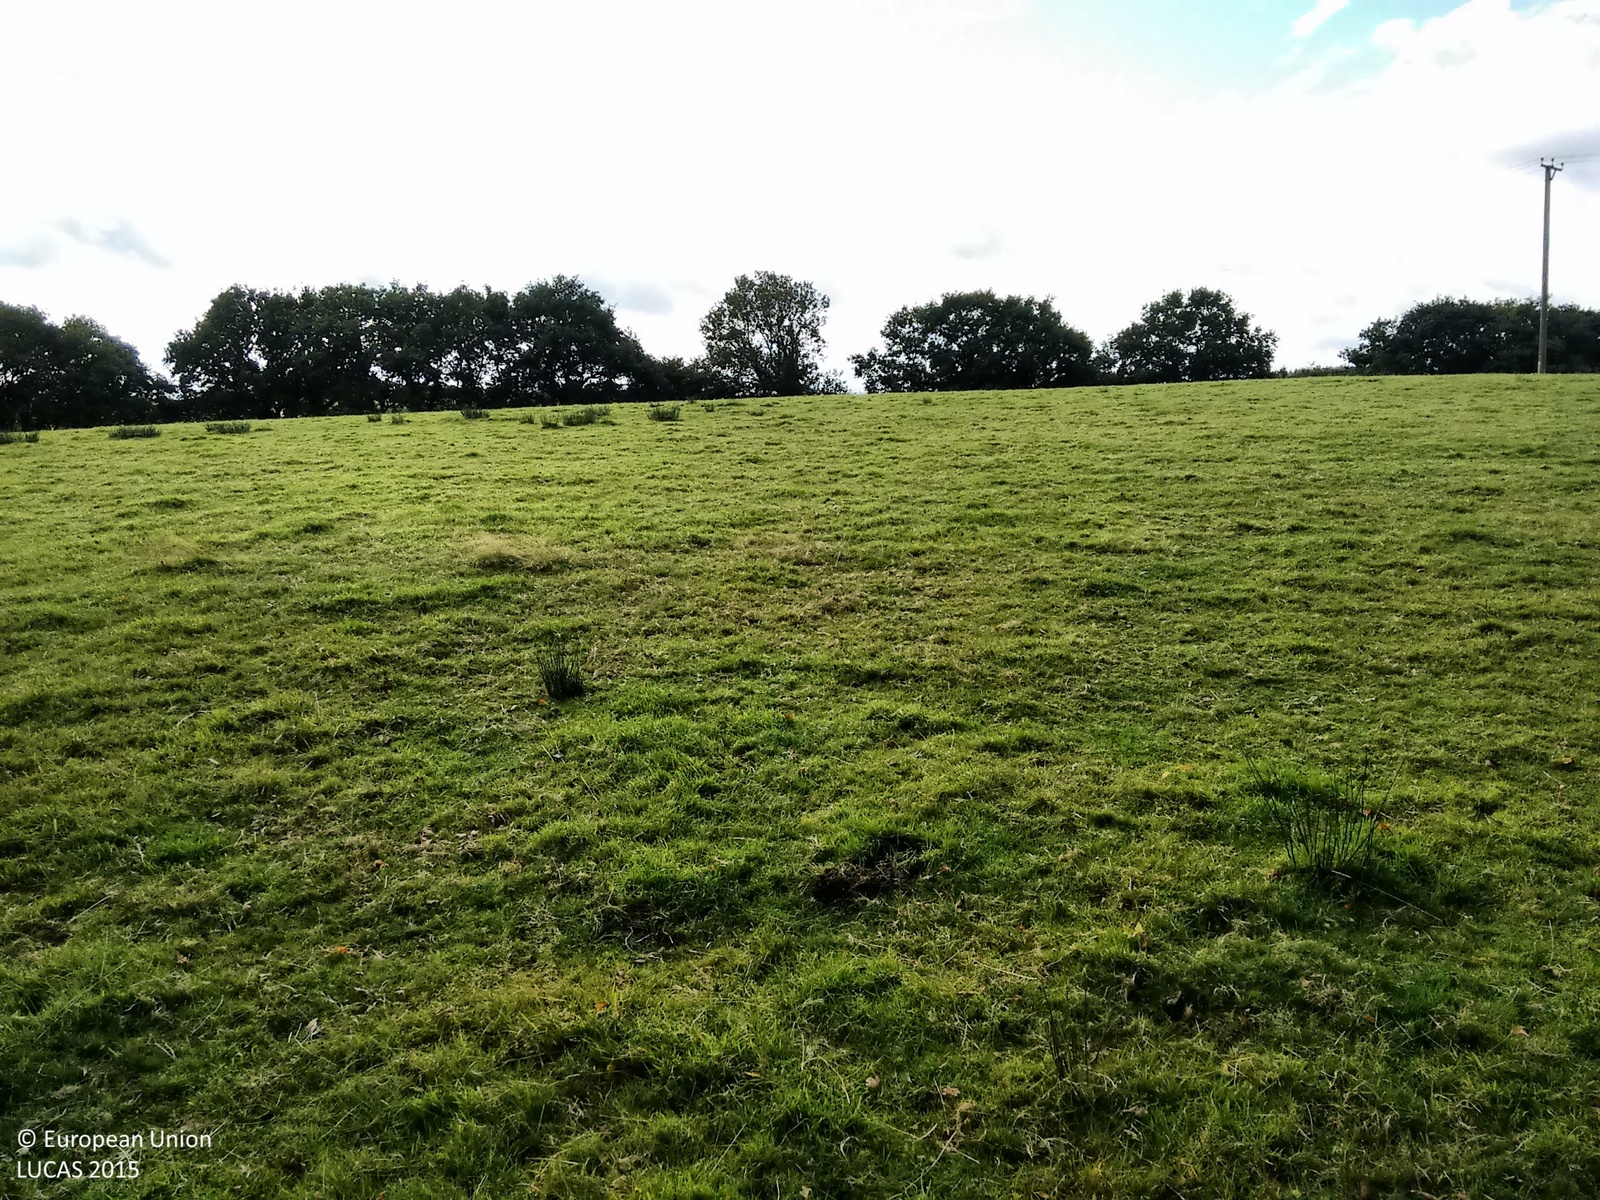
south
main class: Grassland
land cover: Grassland without tree/shrub cover
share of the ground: > 75 %
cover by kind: herbaceous plants 100 %
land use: Agriculture (excluding fallow land and kitchen gardens)
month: September
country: GB
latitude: 50.8383
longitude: -4.0831
